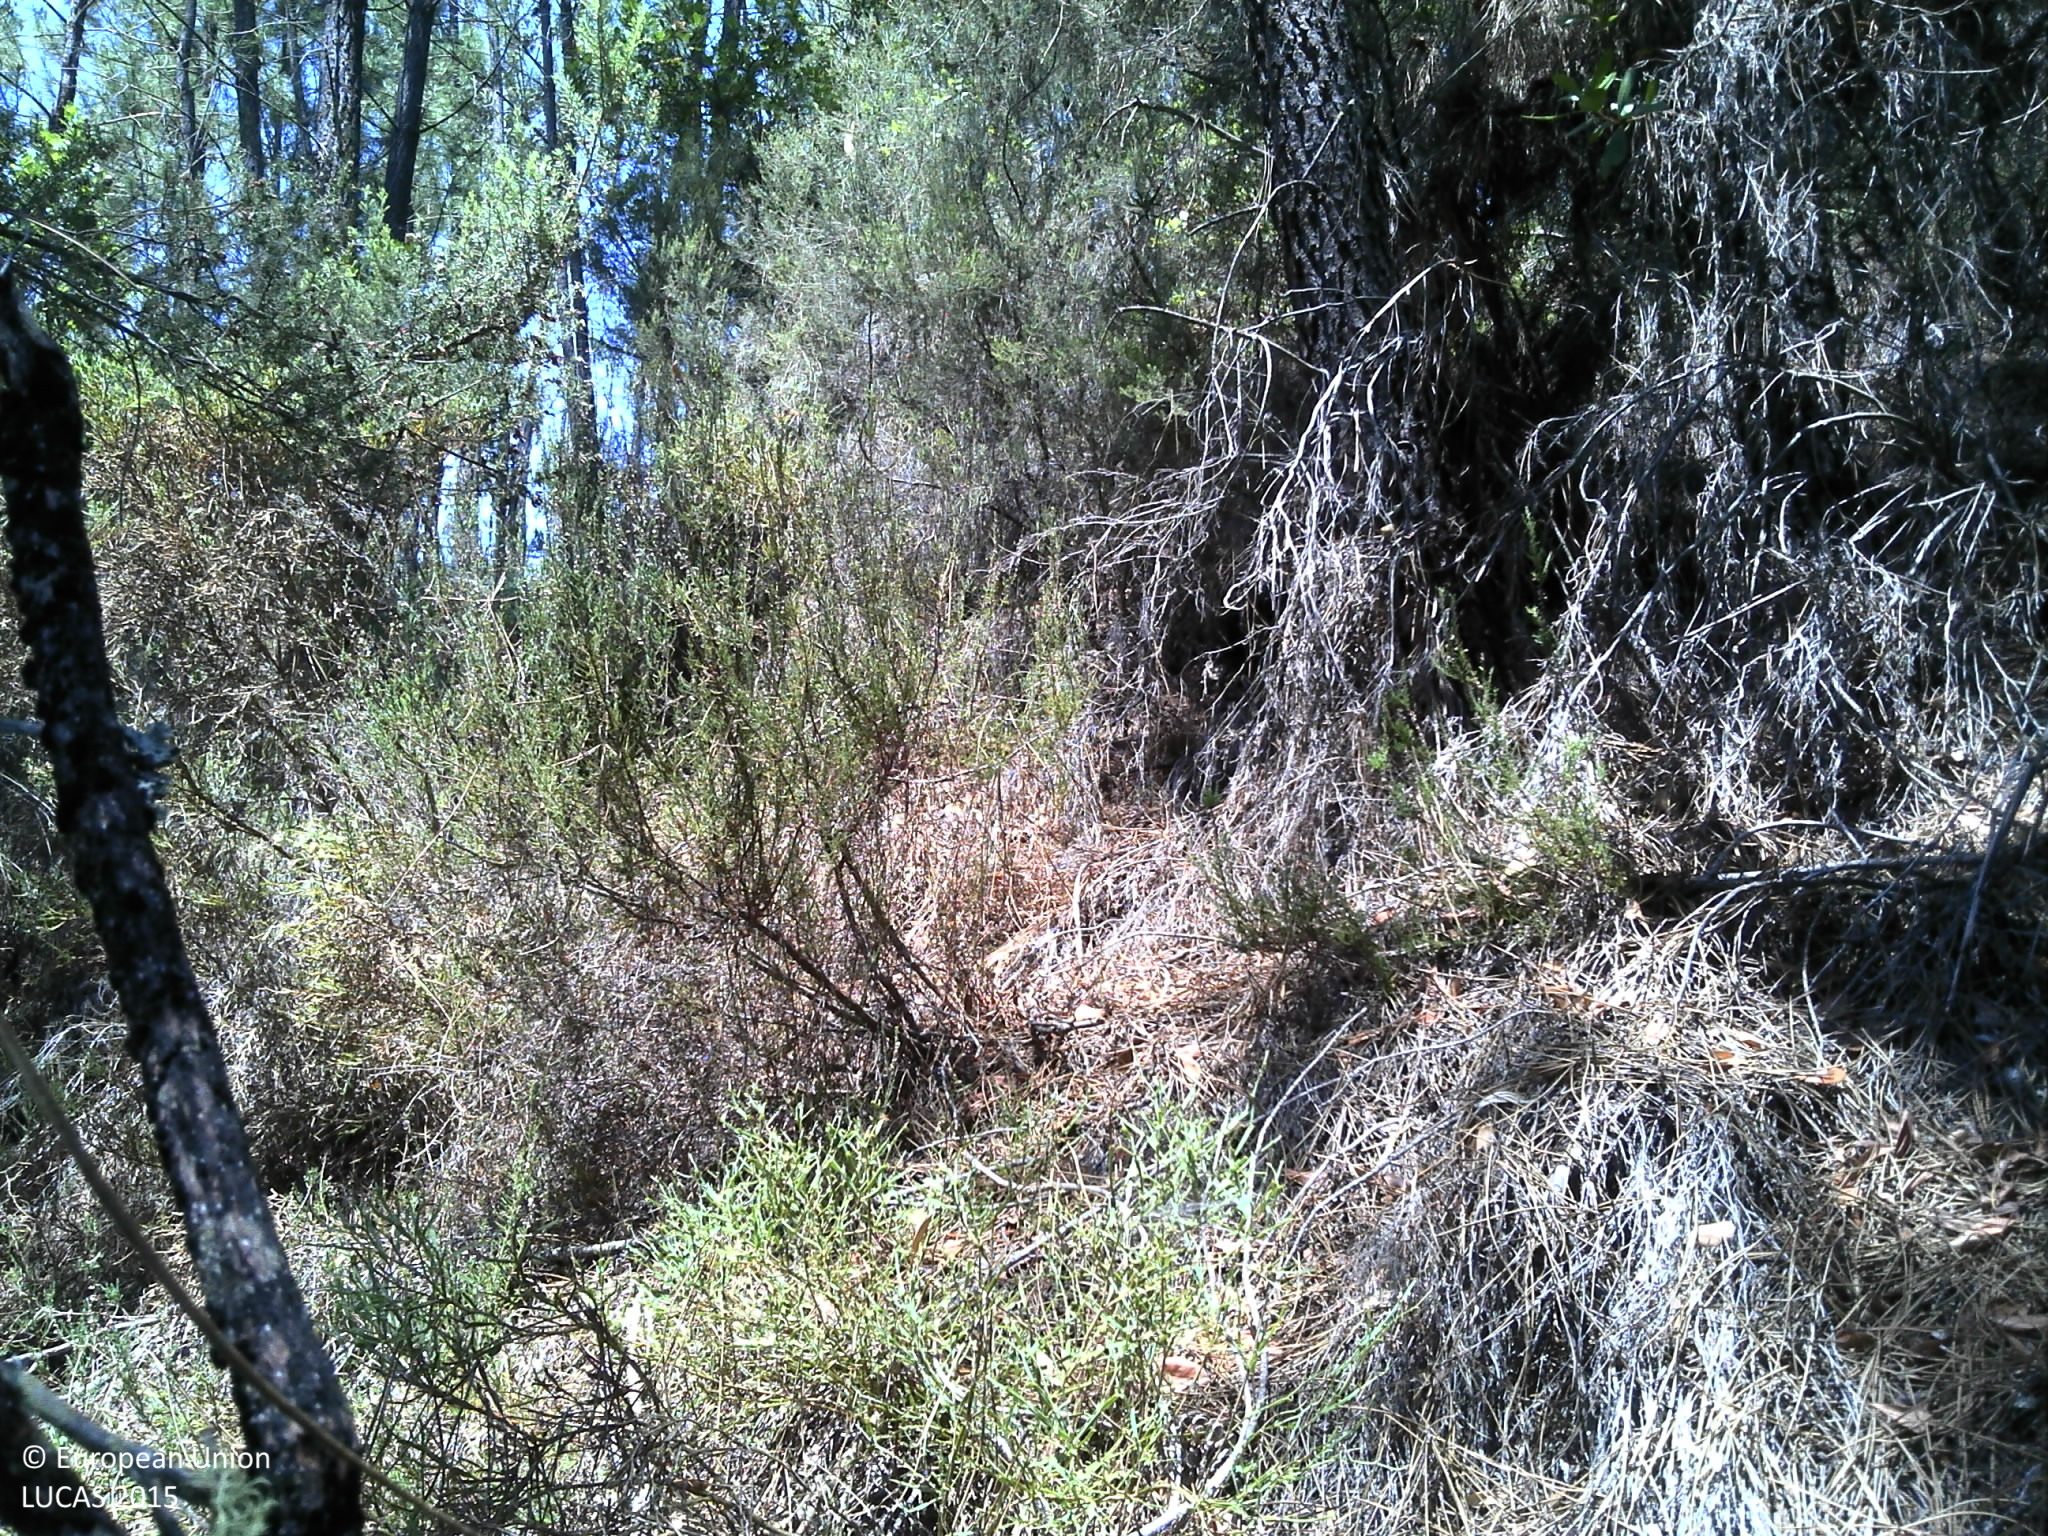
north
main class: Woodland
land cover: Pine dominated coniferous woodland
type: coniferous forest of the mediterranean region
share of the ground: 25 - 50 %
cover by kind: shrubs 50 %, coniferous forest trees 35 %, unconsolidated bare surface 15 %
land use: Forestry
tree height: > 5 m
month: June
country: PT
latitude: 40.0182
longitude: -8.0546
